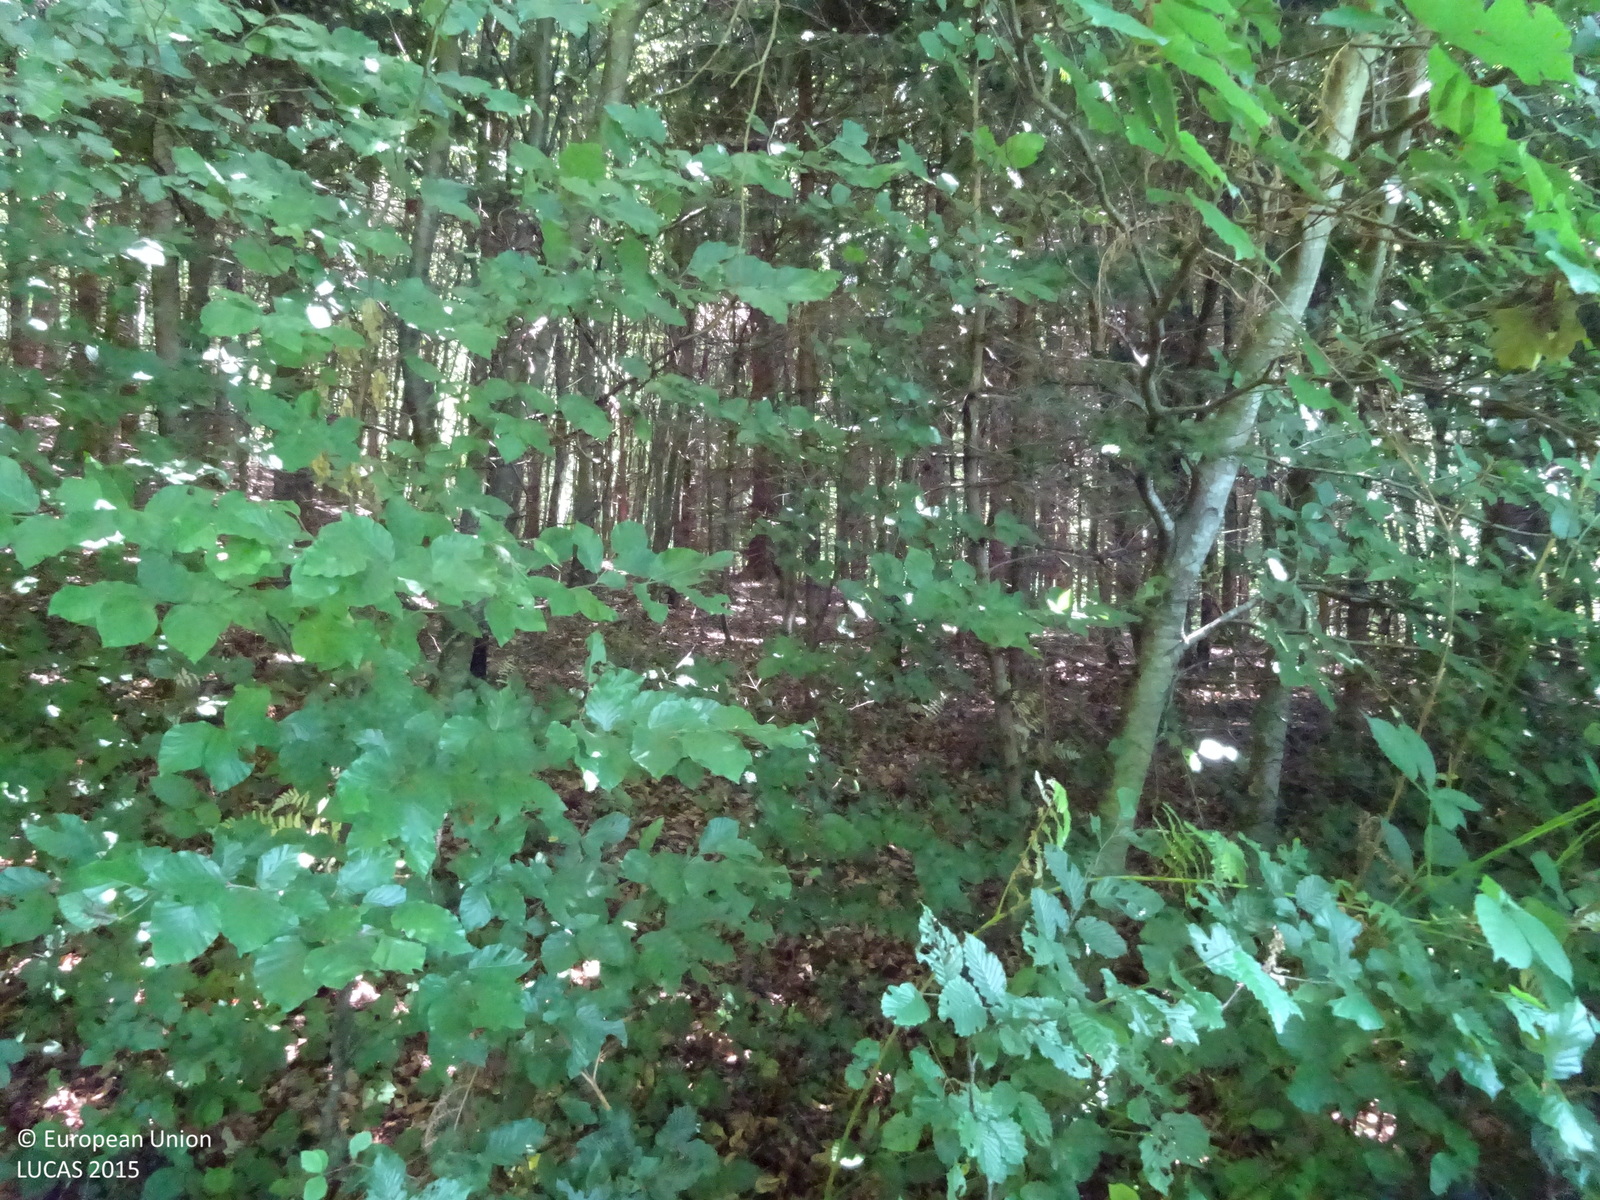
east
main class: Shrubland
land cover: Shrubland with sparse tree cover
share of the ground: > 75 %
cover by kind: shrubs 95 %, broadleaved forest trees 5 %
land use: Forestry
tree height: > 5 m
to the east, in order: Shrubland with sparse tree cover; Spruce dominated coniferous woodland; Pine dominated mixed woodland; Broadleaved woodland; Rivers and streams; Broadleaved woodland; Spruce dominated coniferous woodland; Broadleaved woodland
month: July
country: AT
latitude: 46.8797
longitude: 16.1289
